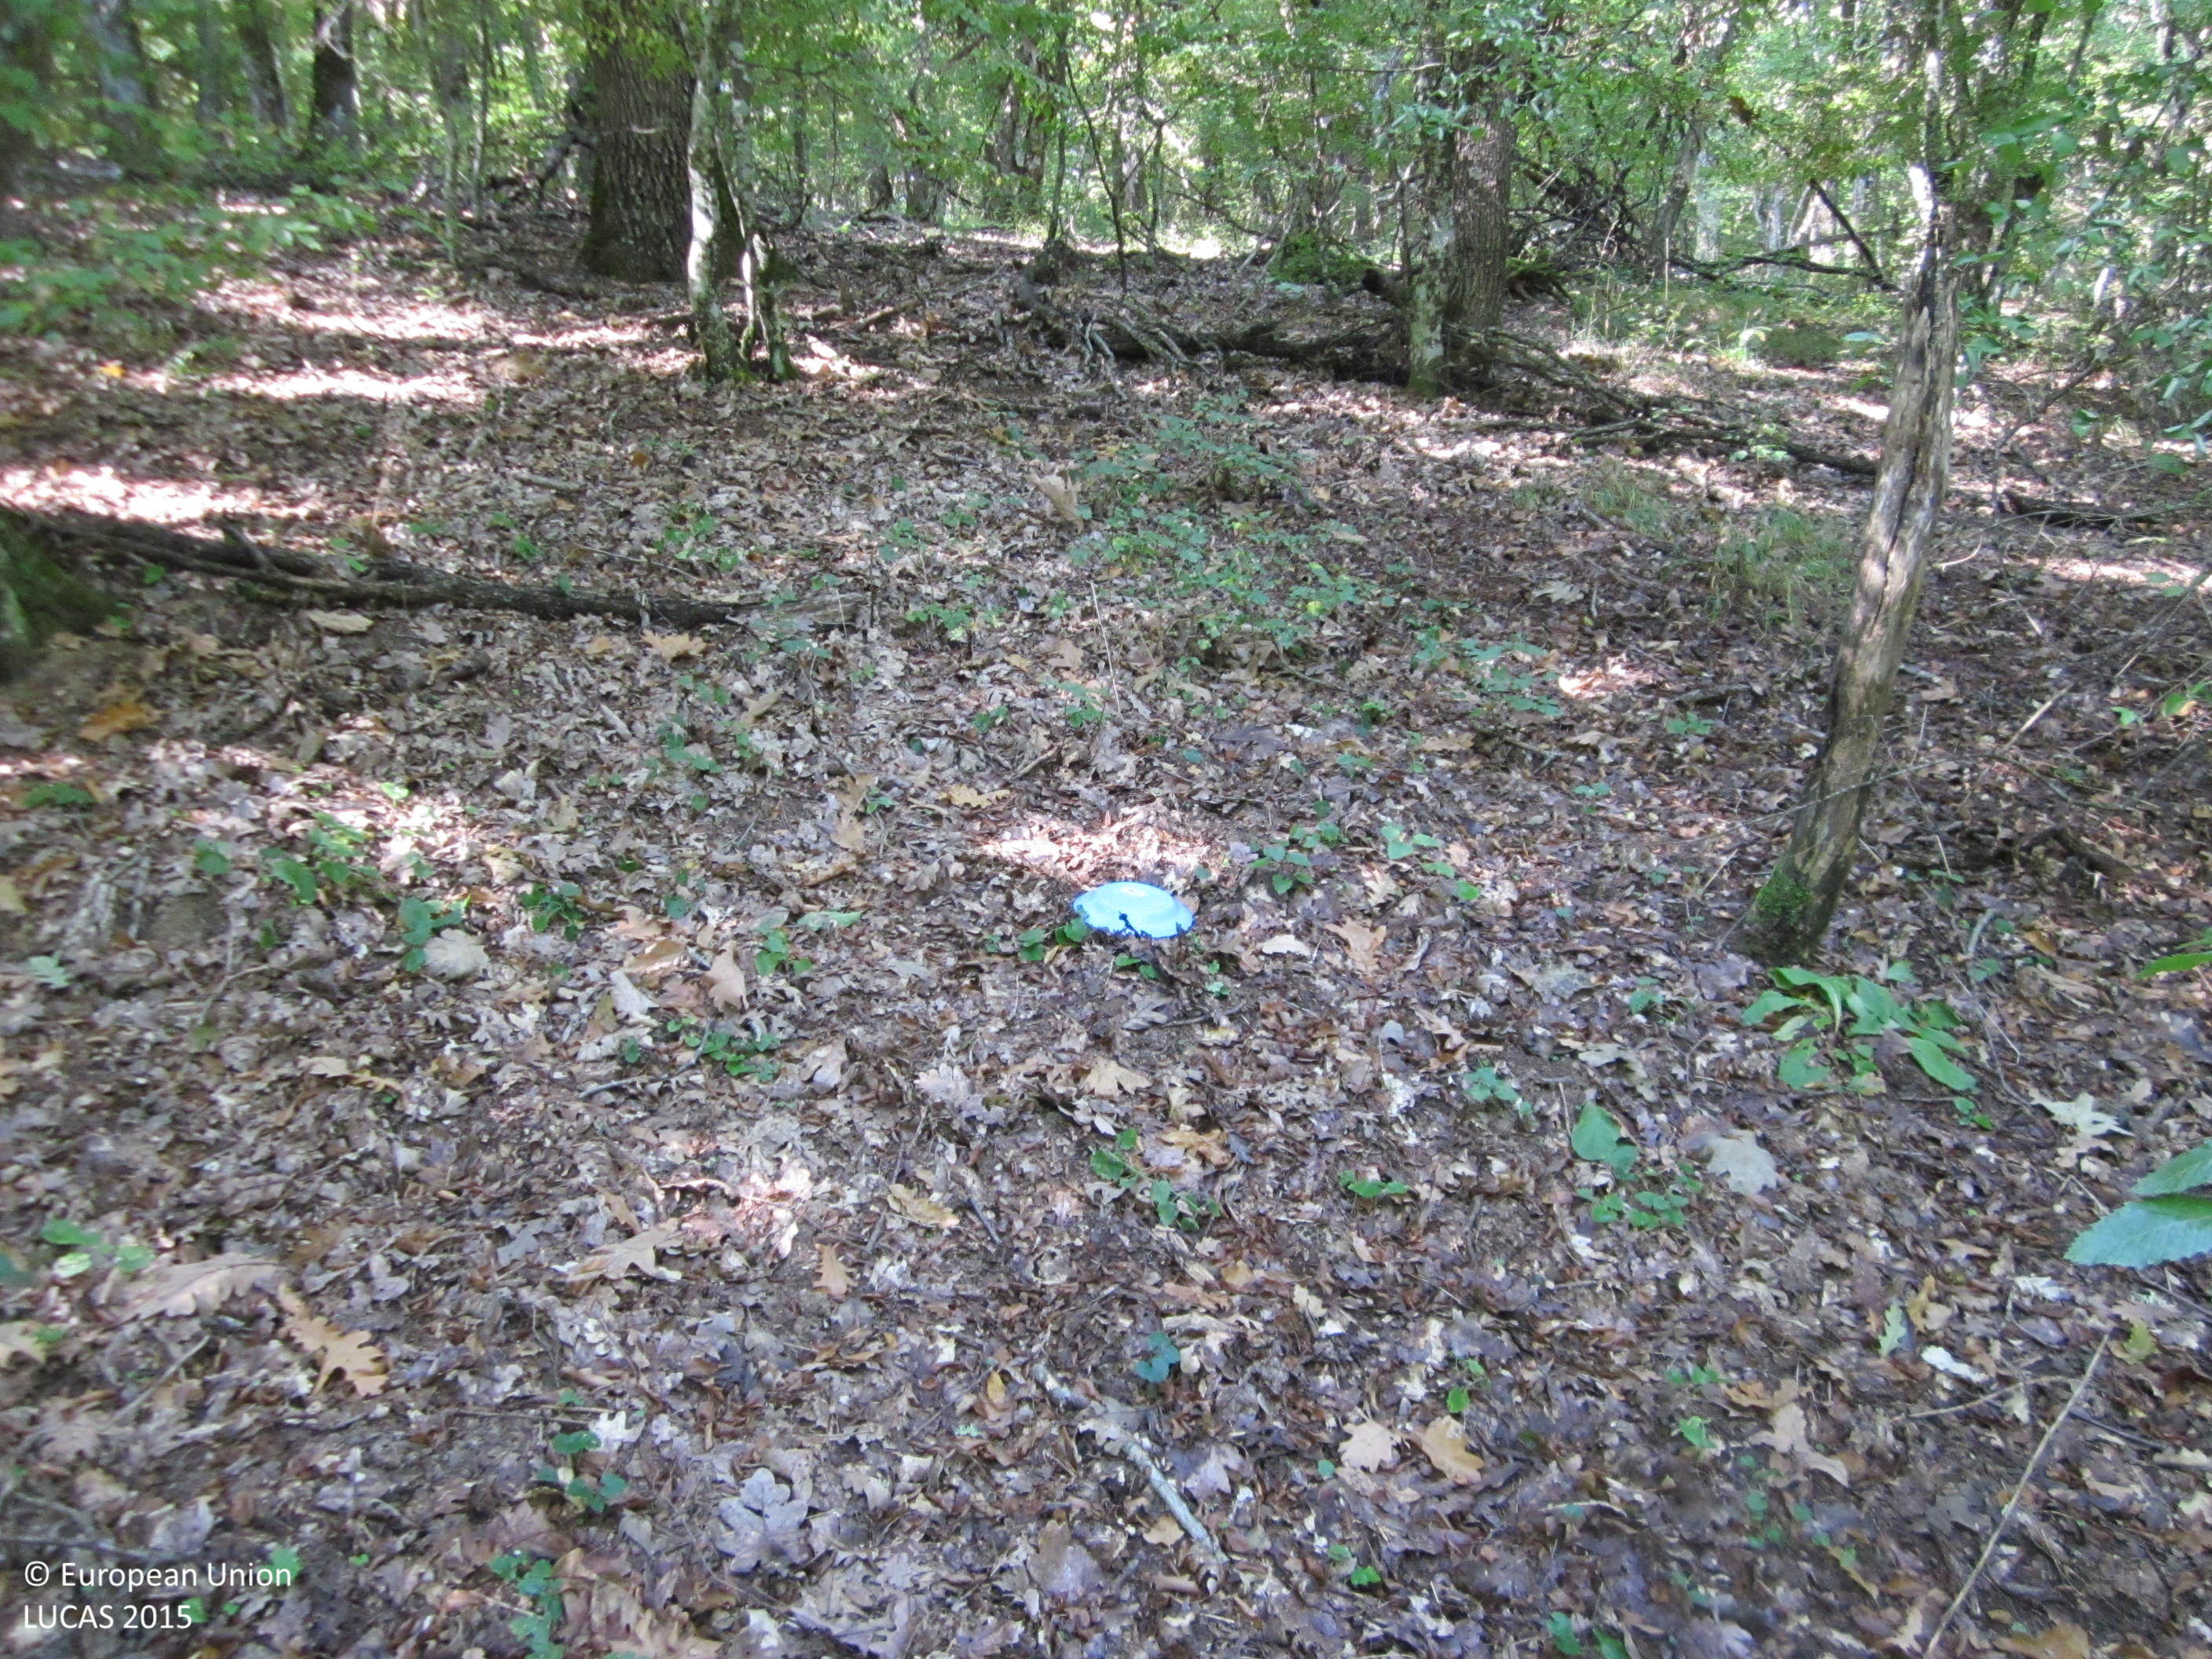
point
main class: Woodland
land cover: Broadleaved woodland
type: thermophilous deciduous forest
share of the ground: > 75 %
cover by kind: broadleaved forest trees 100 %
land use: Forestry
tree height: > 5 m
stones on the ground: < 10 %
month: September
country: BG
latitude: 42.2198
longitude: 27.1996
